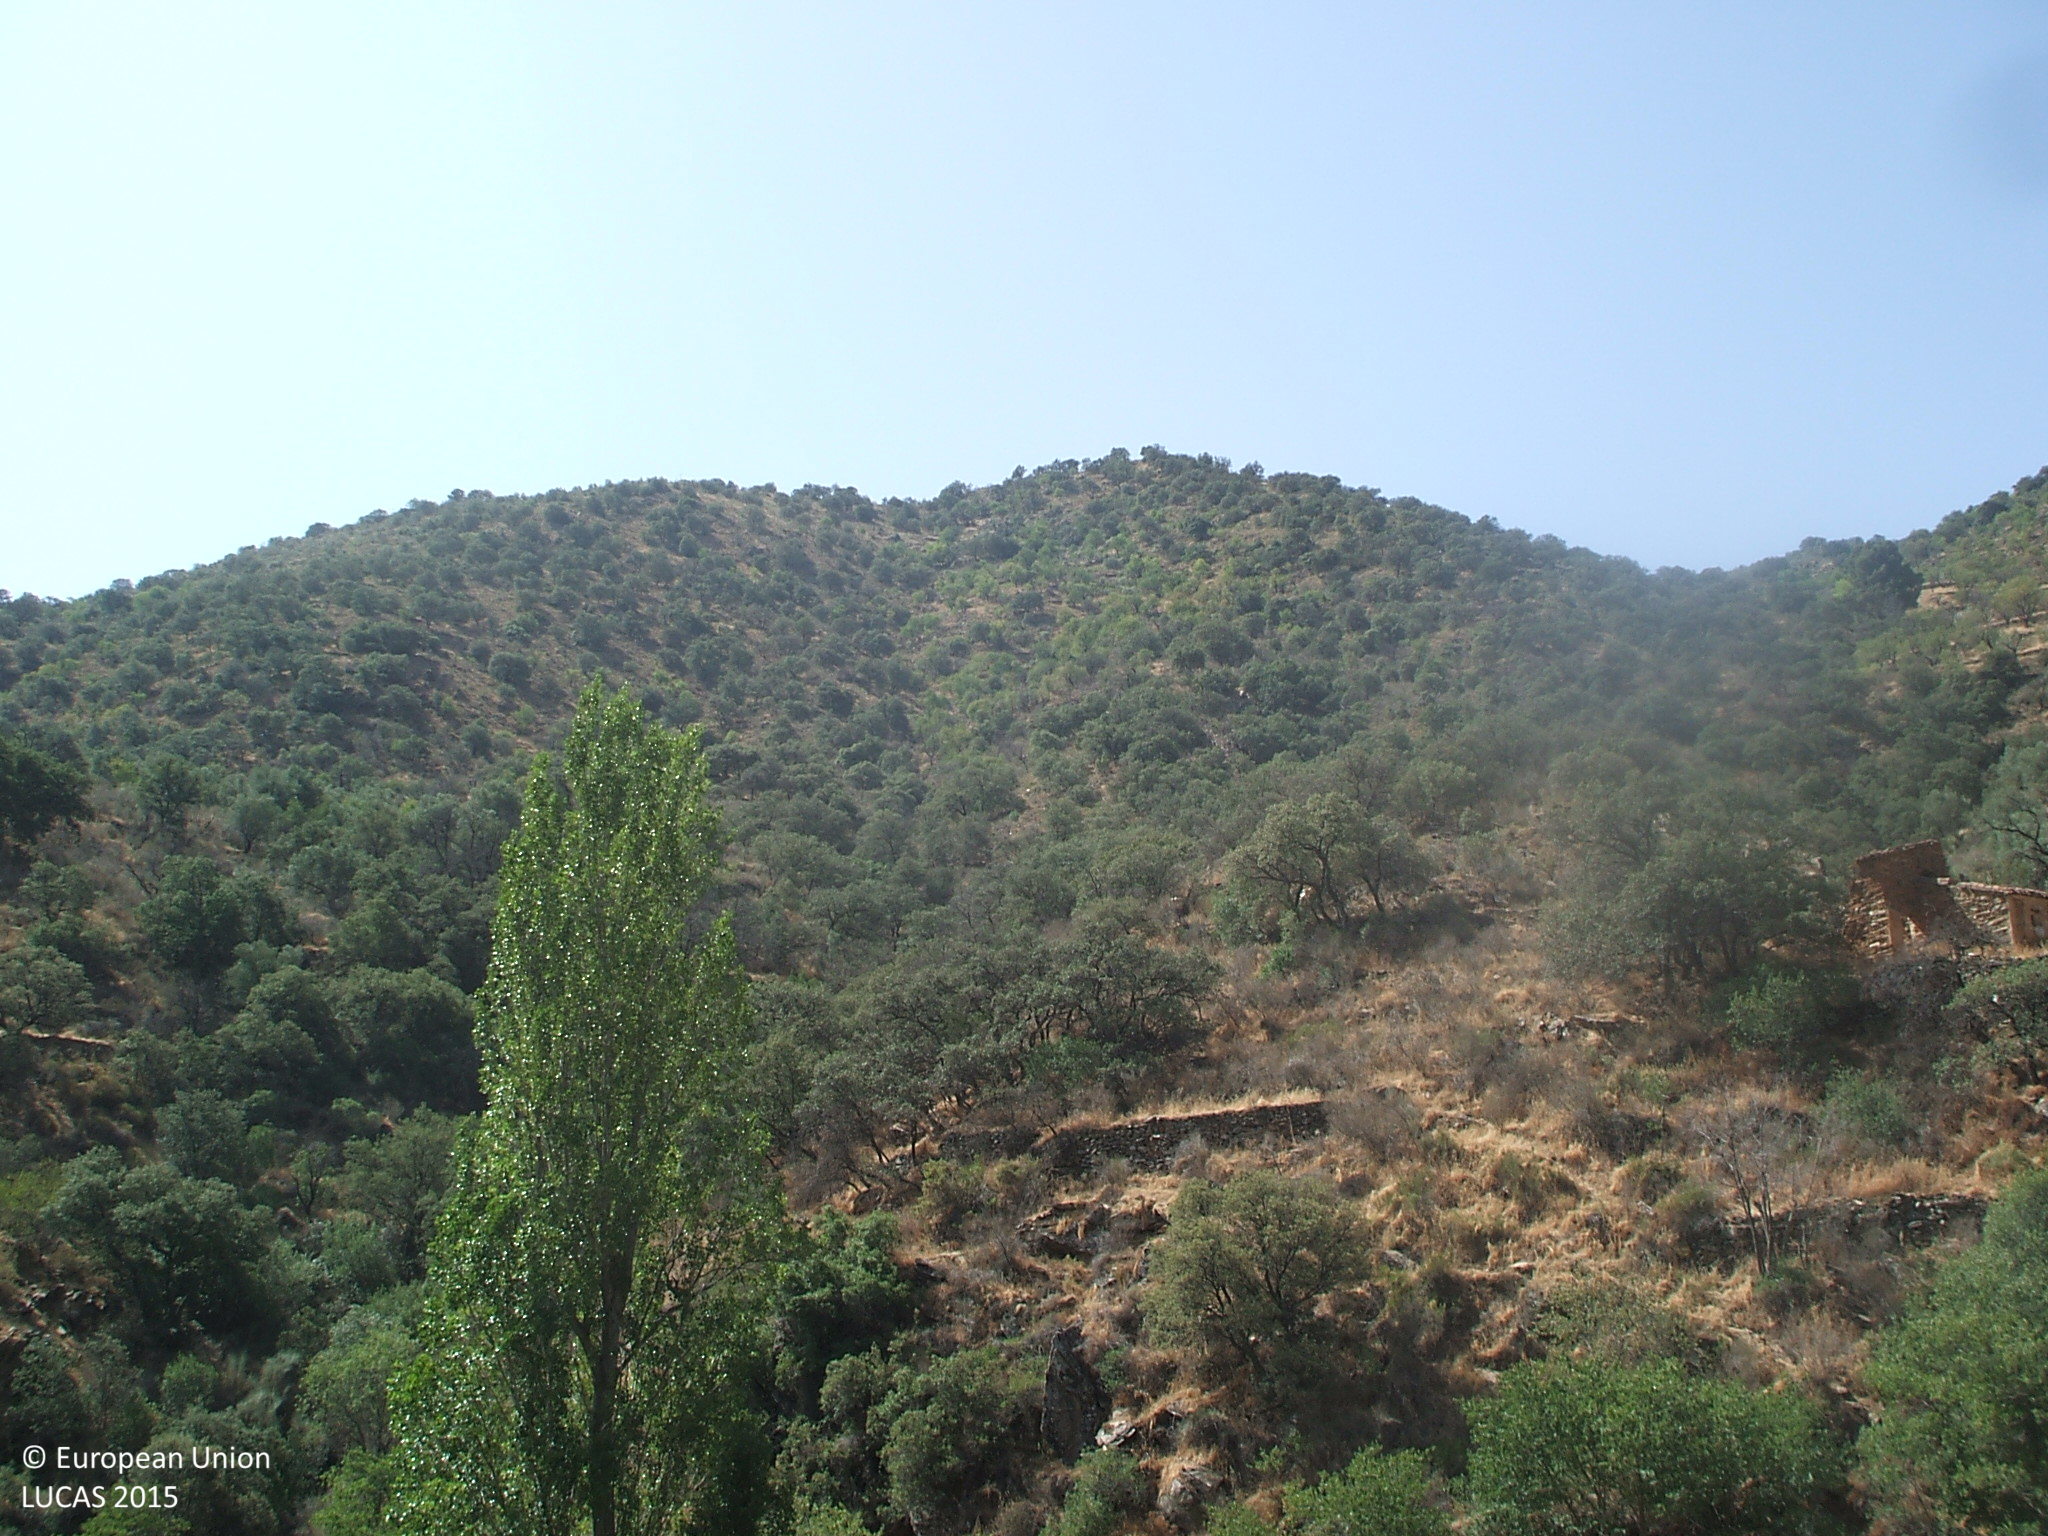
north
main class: Woodland
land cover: Broadleaved woodland
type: broadleaved evergreen forest
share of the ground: 10 - 25 %
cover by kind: herbaceous plants 70 %, broadleaved forest trees 15 %, shrubs 15 %
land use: Semi-natural and natural areas not in use
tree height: > 5 m
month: July
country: ES
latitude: 37.2897
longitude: -2.3326
